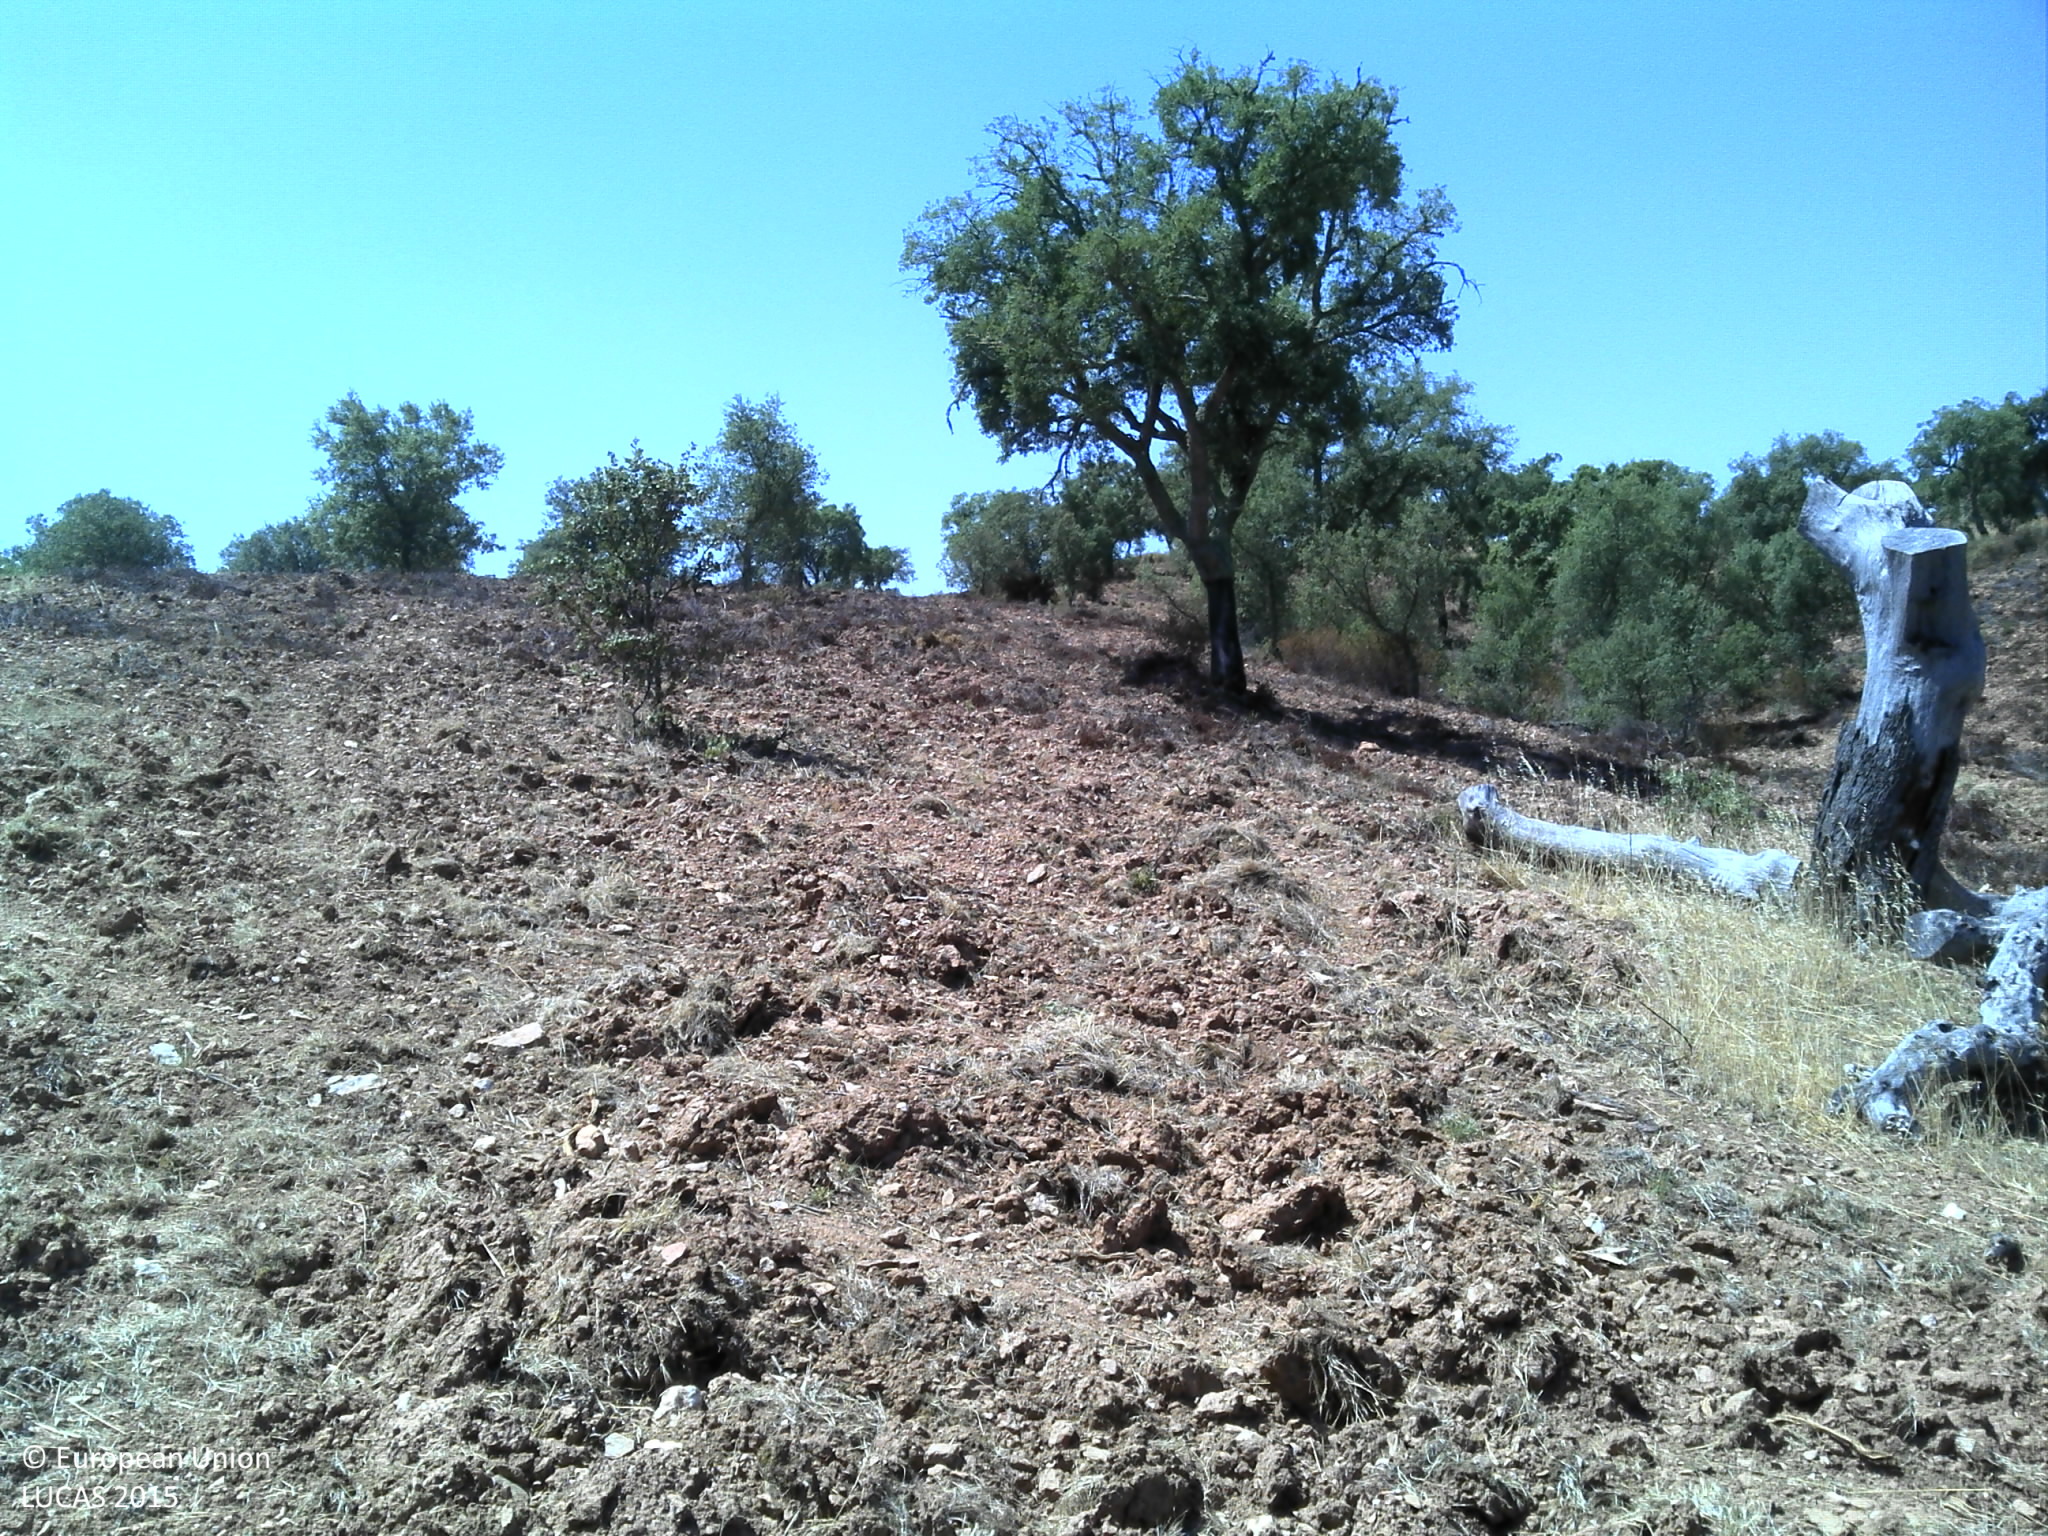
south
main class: Grassland
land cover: Grassland with sparse tree/shrub cover
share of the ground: 10 - 25 %
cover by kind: unconsolidated bare surface 75 %, herbaceous plants 20 %, broadleaved forest trees 5 %
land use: Agriculture (excluding fallow land and kitchen gardens)
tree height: < 5 m
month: June
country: PT
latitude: 37.8481
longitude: -7.5063
